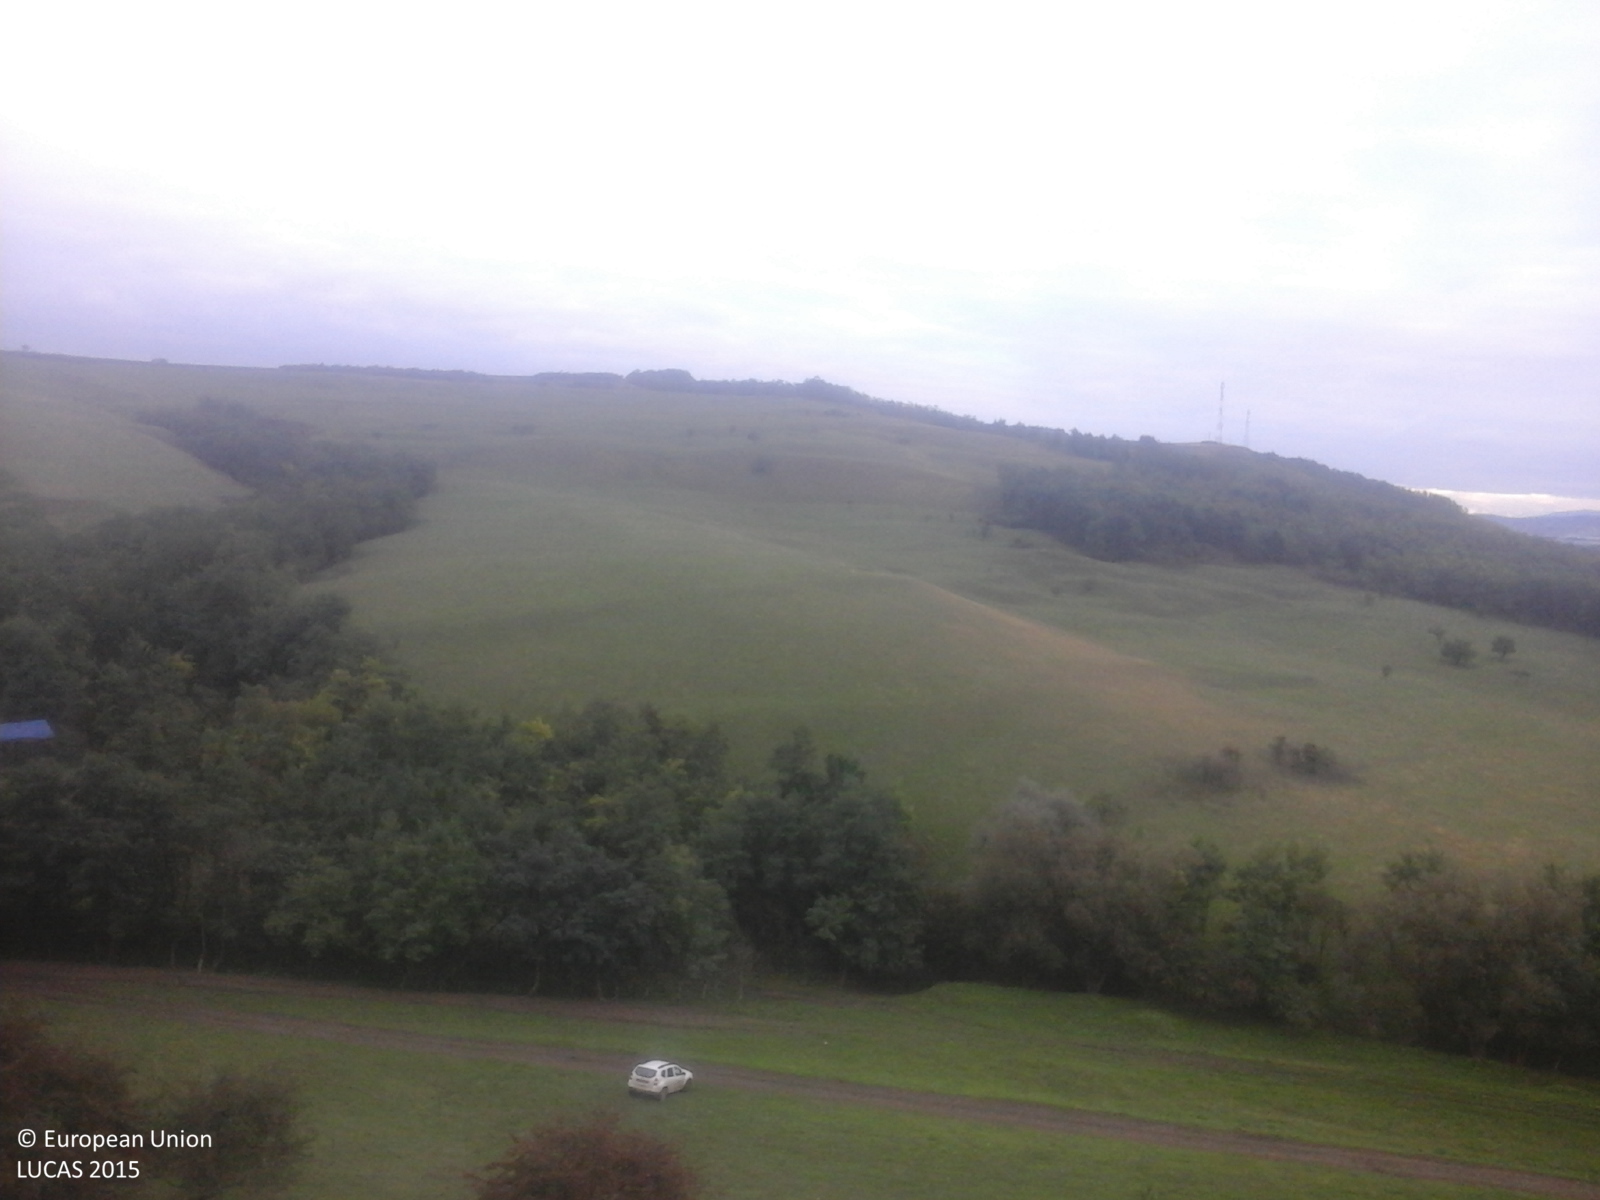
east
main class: Grassland
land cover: Grassland without tree/shrub cover
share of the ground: > 75 %
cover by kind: herbaceous plants 100 %
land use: Agriculture (excluding fallow land and kitchen gardens)
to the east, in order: Grassland without tree/shrub cover; Tracks; Grassland without tree/shrub cover; Abandoned hedges; Ditches and canals; Abandoned hedges; Grassland without tree/shrub cover; Tracks; Grassland without tree/shrub cover; Broadleaved woodland; Ditches and canals; Broadleaved woodland; Shrubland without tree cover
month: September
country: RO
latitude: 45.9150
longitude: 23.7474
